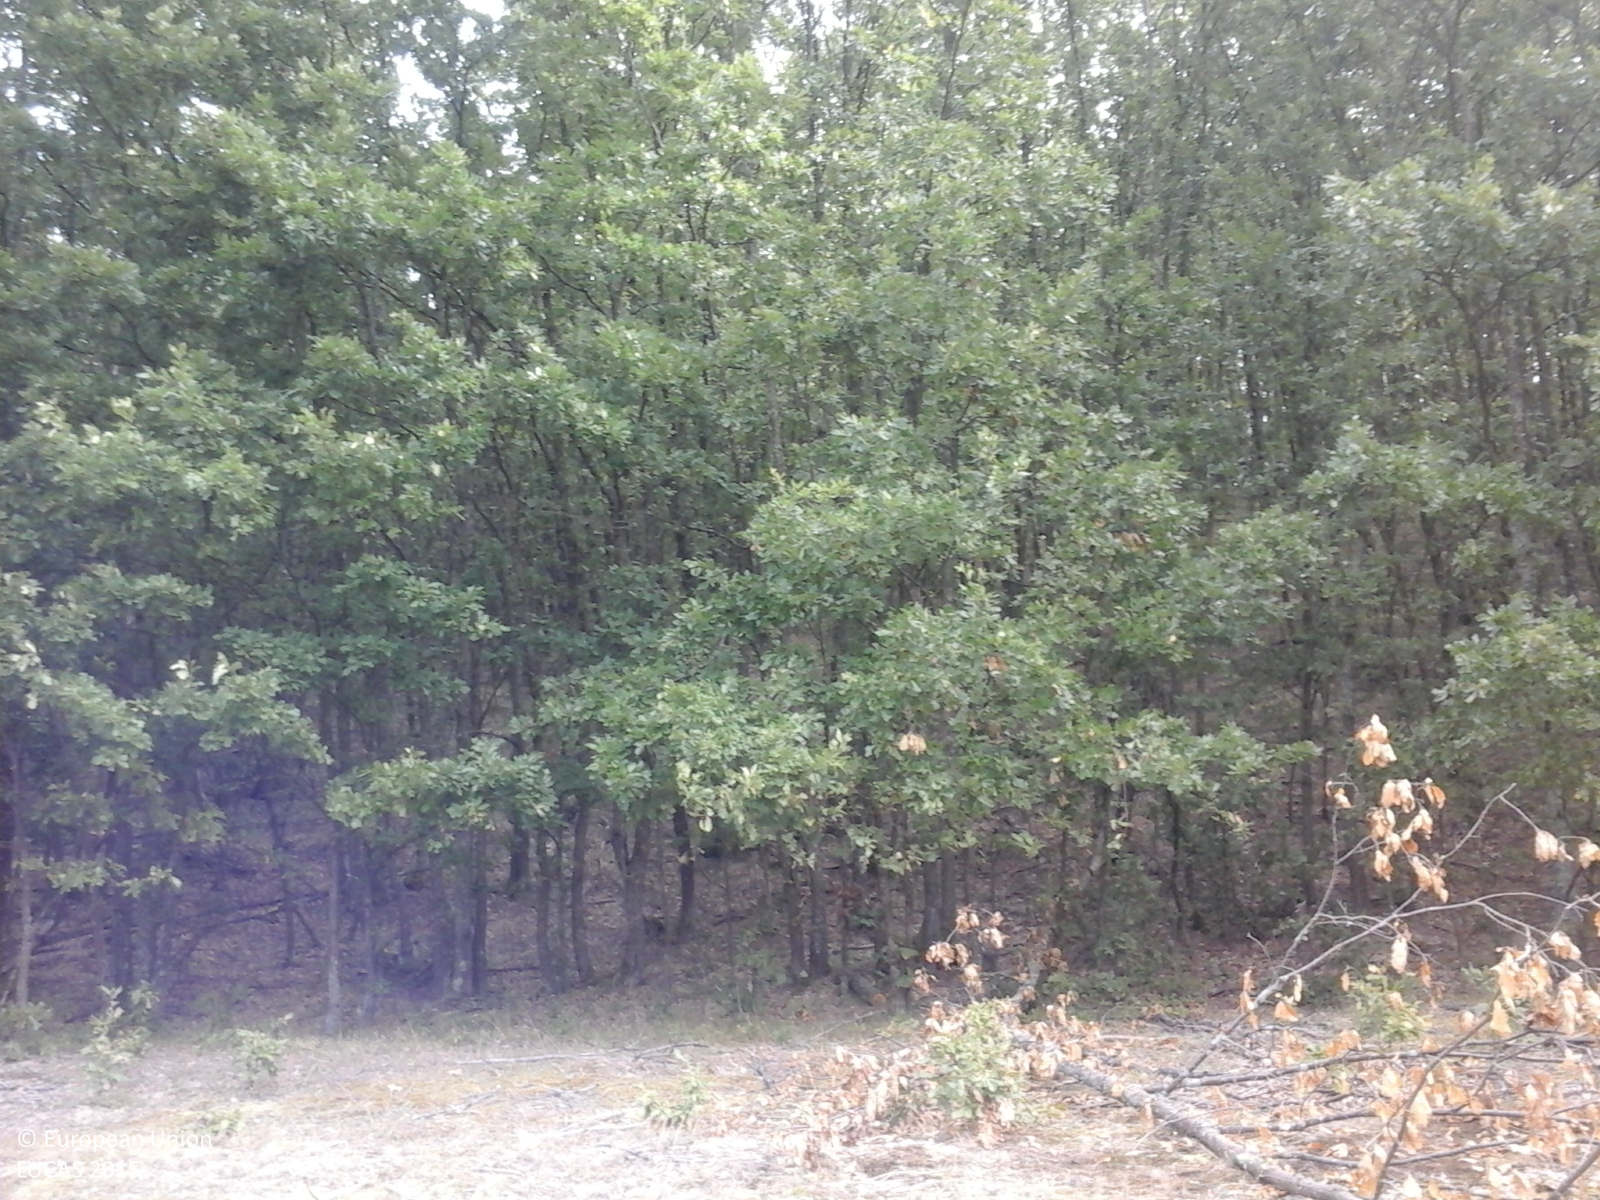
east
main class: Grassland
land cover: Grassland without tree/shrub cover
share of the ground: > 75 %
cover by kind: herbaceous plants 100 %
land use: Agriculture (excluding fallow land and kitchen gardens)
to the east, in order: Grassland without tree/shrub cover; Grassland with sparse tree/shrub cover; Broadleaved woodland; Grassland with sparse tree/shrub cover; Grassland without tree/shrub cover; Grassland with sparse tree/shrub cover
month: September
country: RO
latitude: 46.9393
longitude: 23.0011
